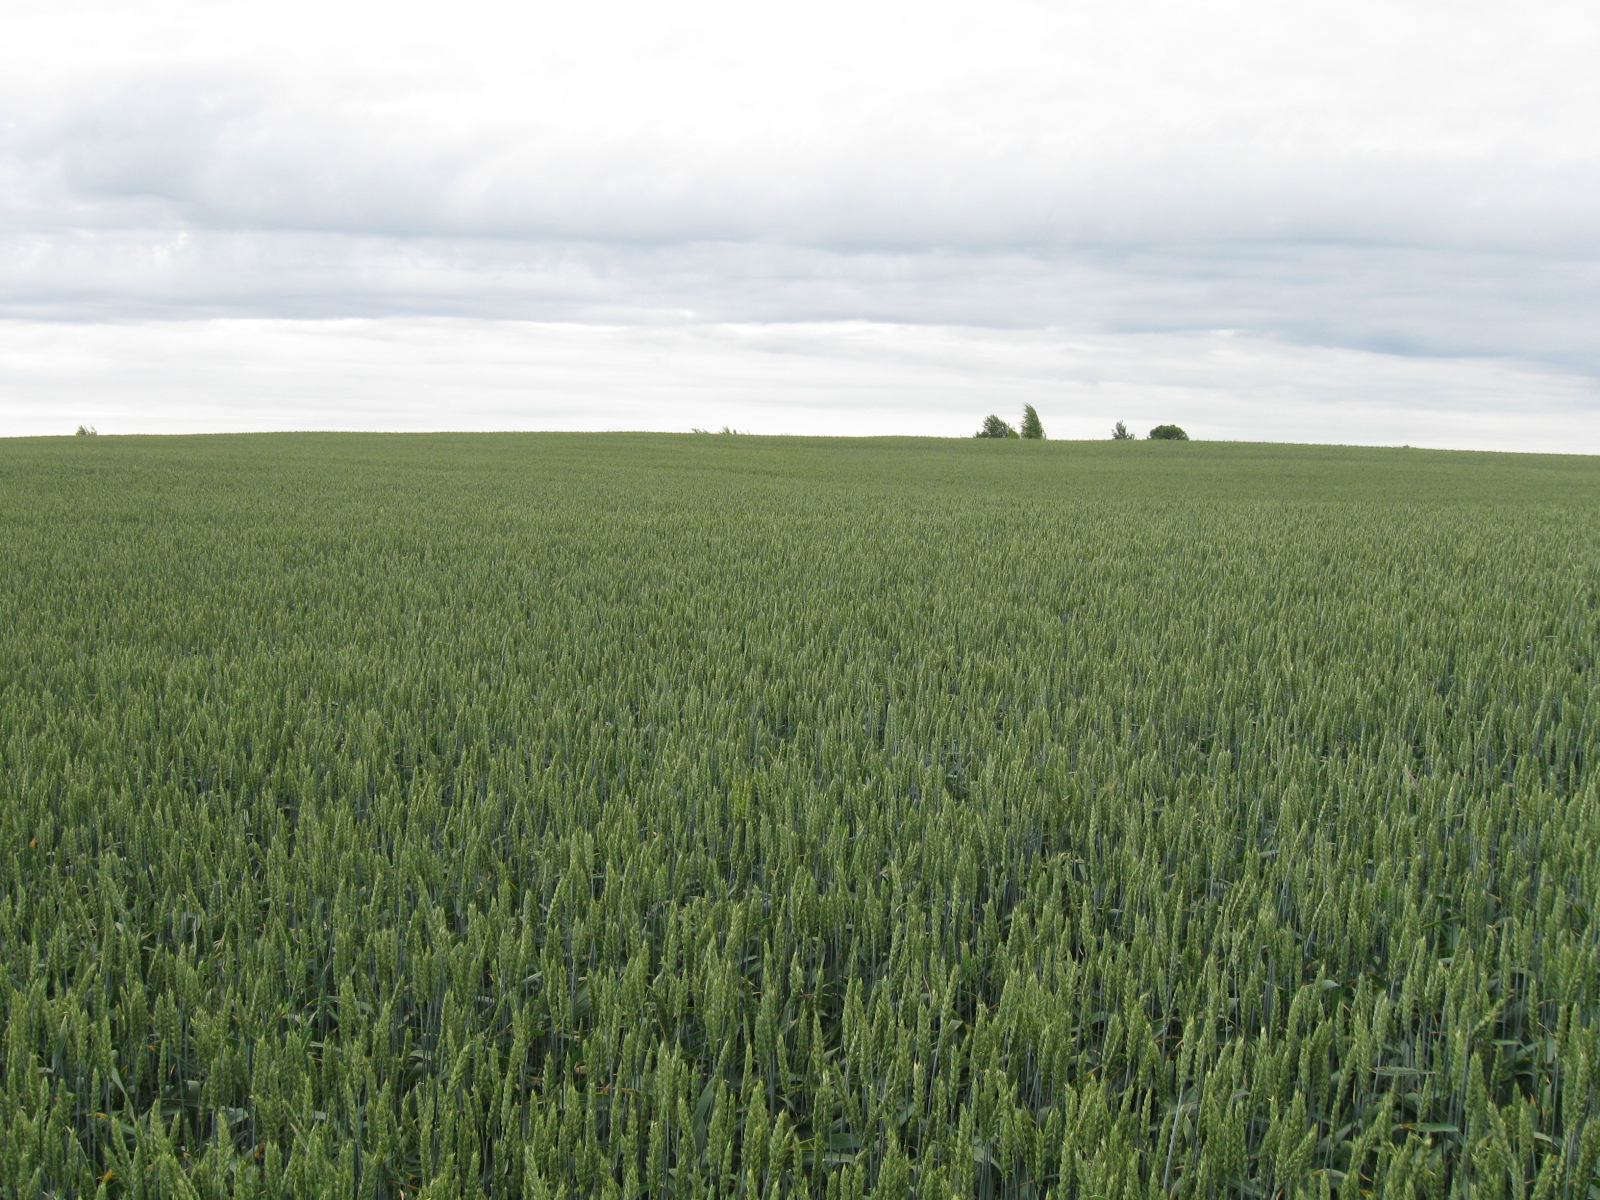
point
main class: Cropland
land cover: Common wheat
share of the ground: > 75 %
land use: Agriculture (excluding fallow land and kitchen gardens)
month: July
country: LT
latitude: 55.0338
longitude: 23.6487
